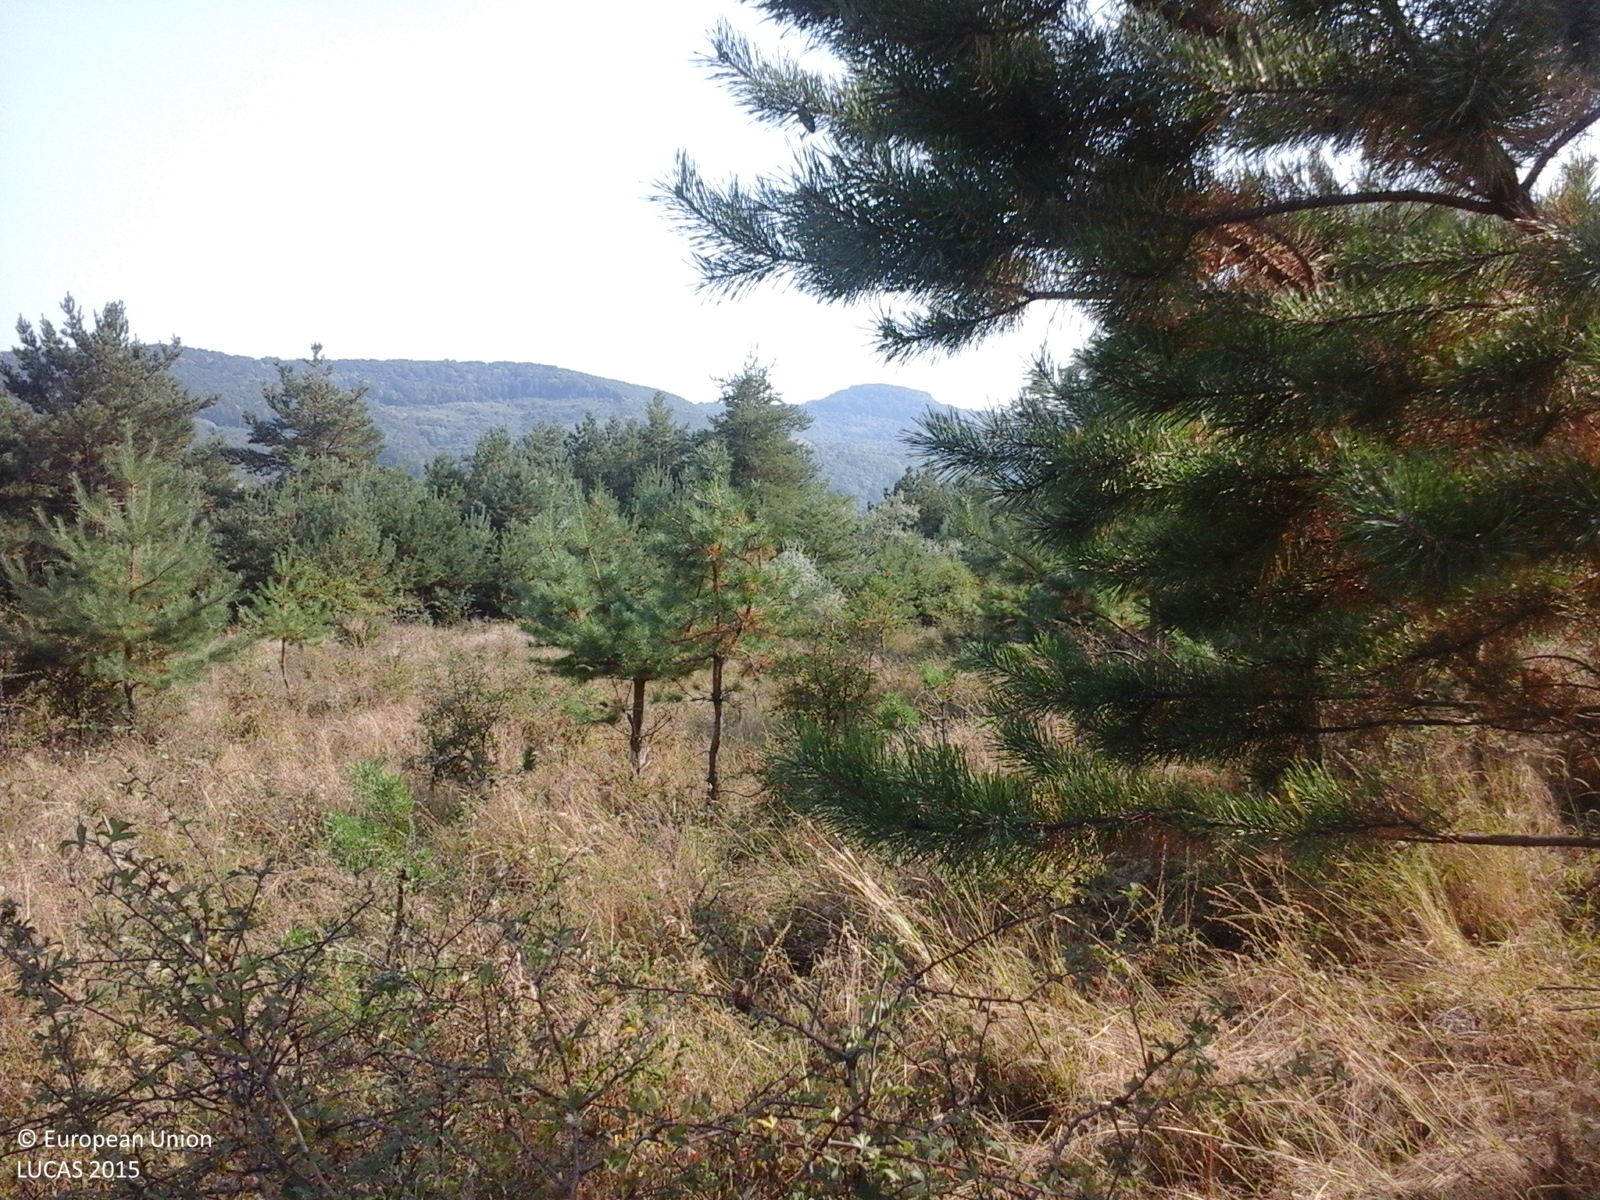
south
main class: Grassland
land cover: Grassland with sparse tree/shrub cover
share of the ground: > 75 %
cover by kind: herbaceous plants 85 %, shrubs 10 %, broadleaved forest trees 5 %
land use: Forestry
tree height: < 5 m
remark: Clear cut
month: September
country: RO
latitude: 47.1226
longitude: 24.1482
